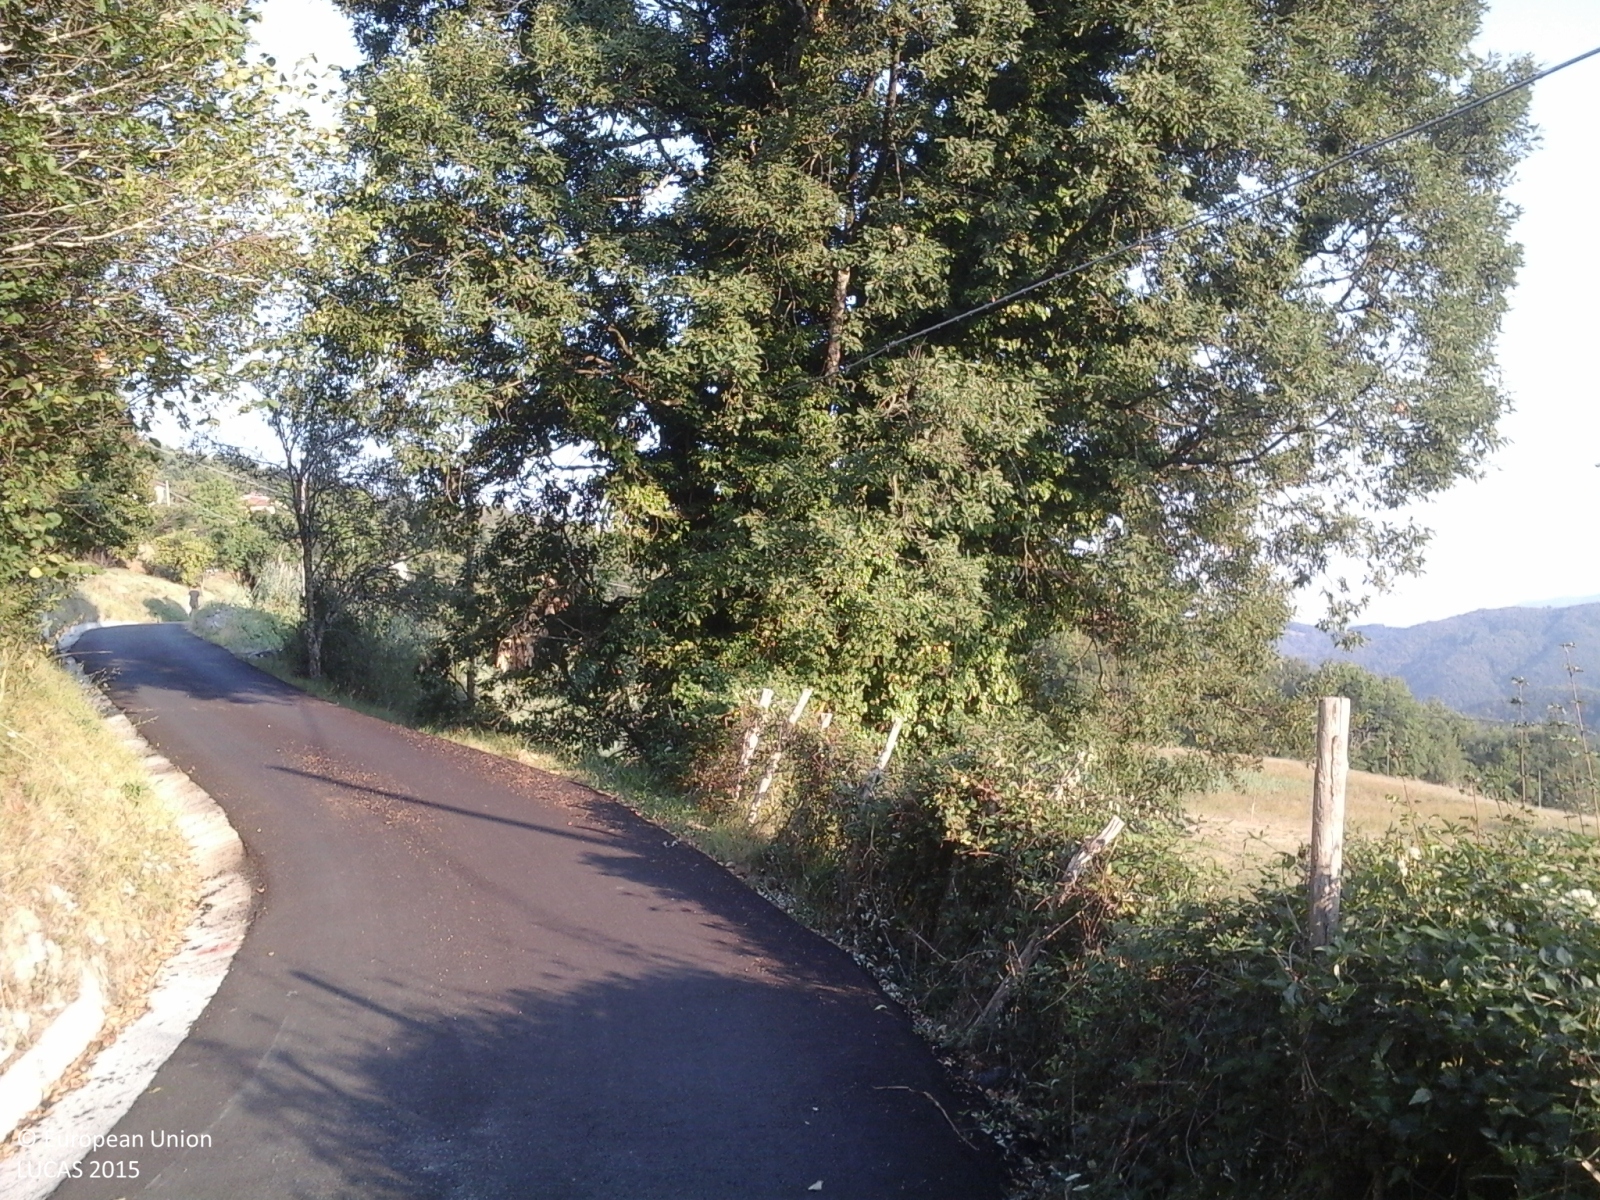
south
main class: Grassland
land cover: Grassland with sparse tree/shrub cover
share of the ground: > 75 %
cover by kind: herbaceous plants 90 %, broadleaved forest trees 5 %, shrubs 5 %
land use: Agriculture (excluding fallow land and kitchen gardens)
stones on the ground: 25 - 50 %
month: August
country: IT
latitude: 44.4037
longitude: 9.5615
